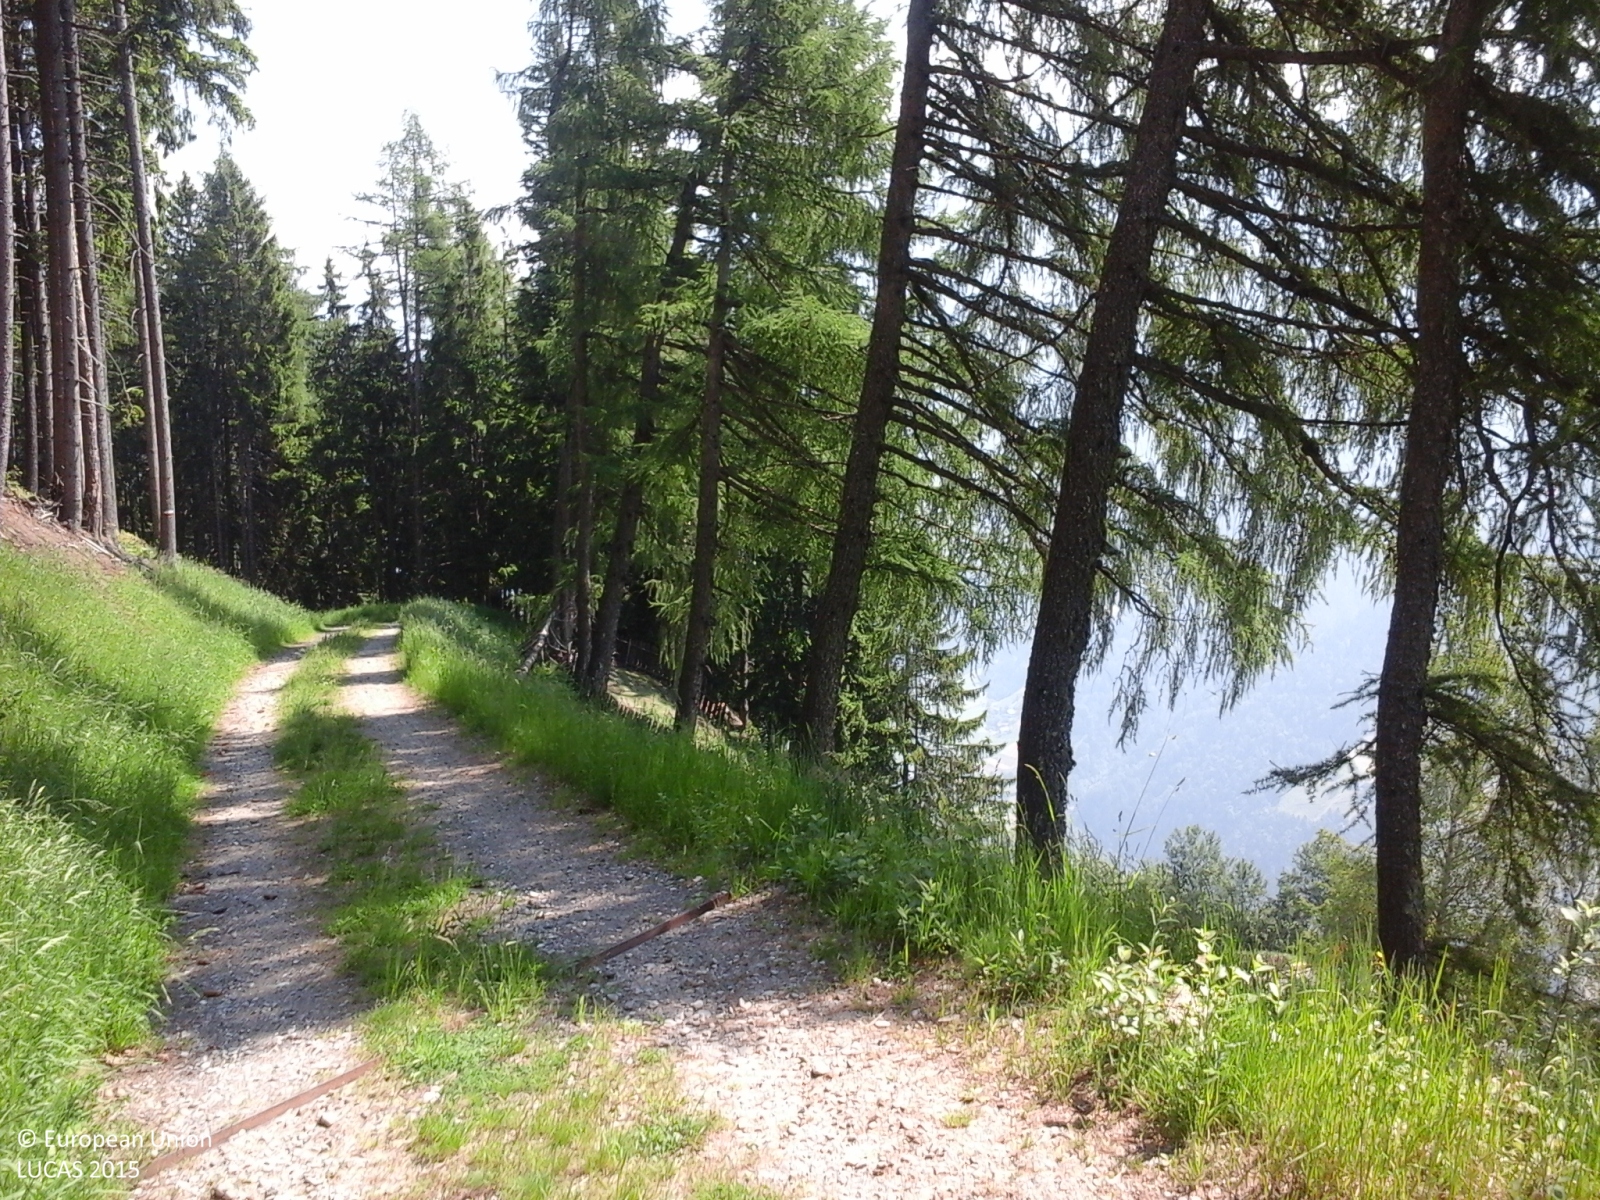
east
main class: Woodland
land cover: Spruce dominated coniferous woodland
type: alpine coniferous forest
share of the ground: > 75 %
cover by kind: coniferous forest trees 100 %
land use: Forestry
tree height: > 5 m
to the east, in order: Spruce dominated coniferous woodland; Tracks; Grassland without tree/shrub cover; Single bushes/trees; Fences; Grassland without tree/shrub cover; Fences; Grassland without tree/shrub cover; Artificial constructions in urban areas; Grassland without tree/shrub cover; Spruce dominated coniferous woodland
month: June
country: IT
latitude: 46.7589
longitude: 11.1901
